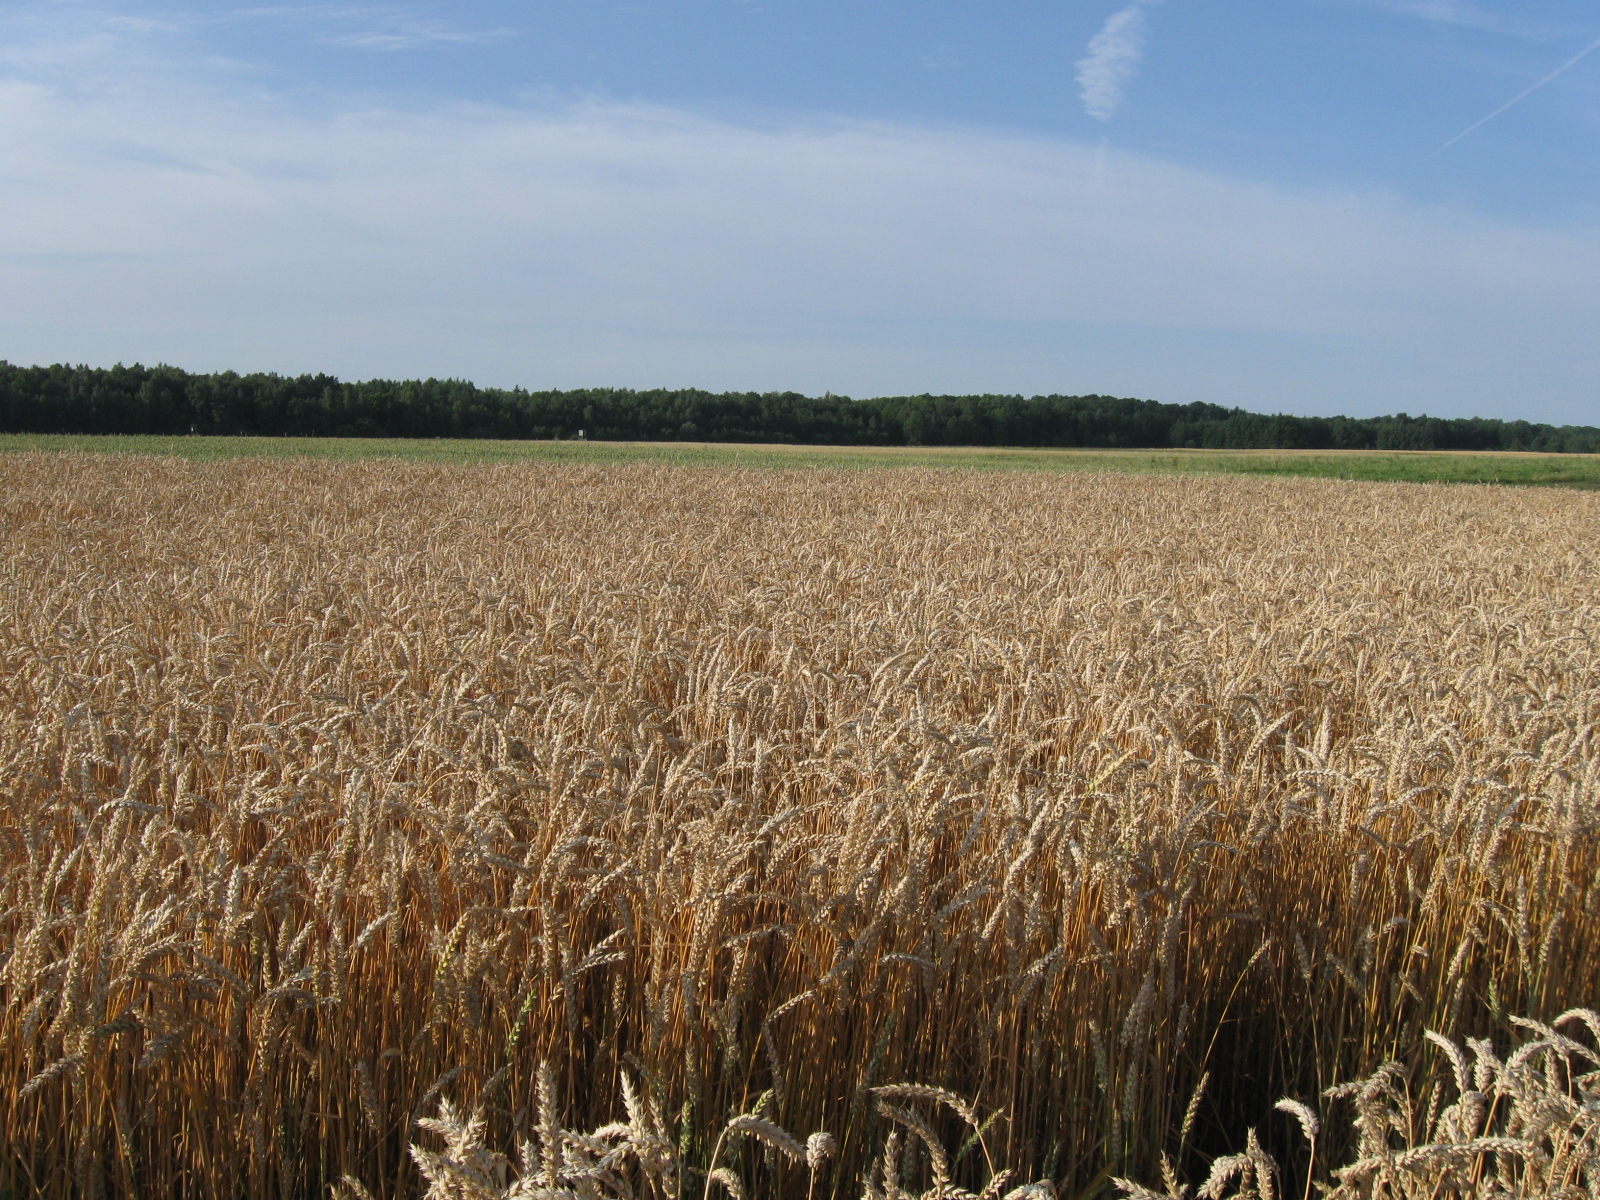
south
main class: Cropland
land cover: Common wheat
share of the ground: > 75 %
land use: Agriculture (excluding fallow land and kitchen gardens)
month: July
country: LT
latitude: 54.4561
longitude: 23.4230
